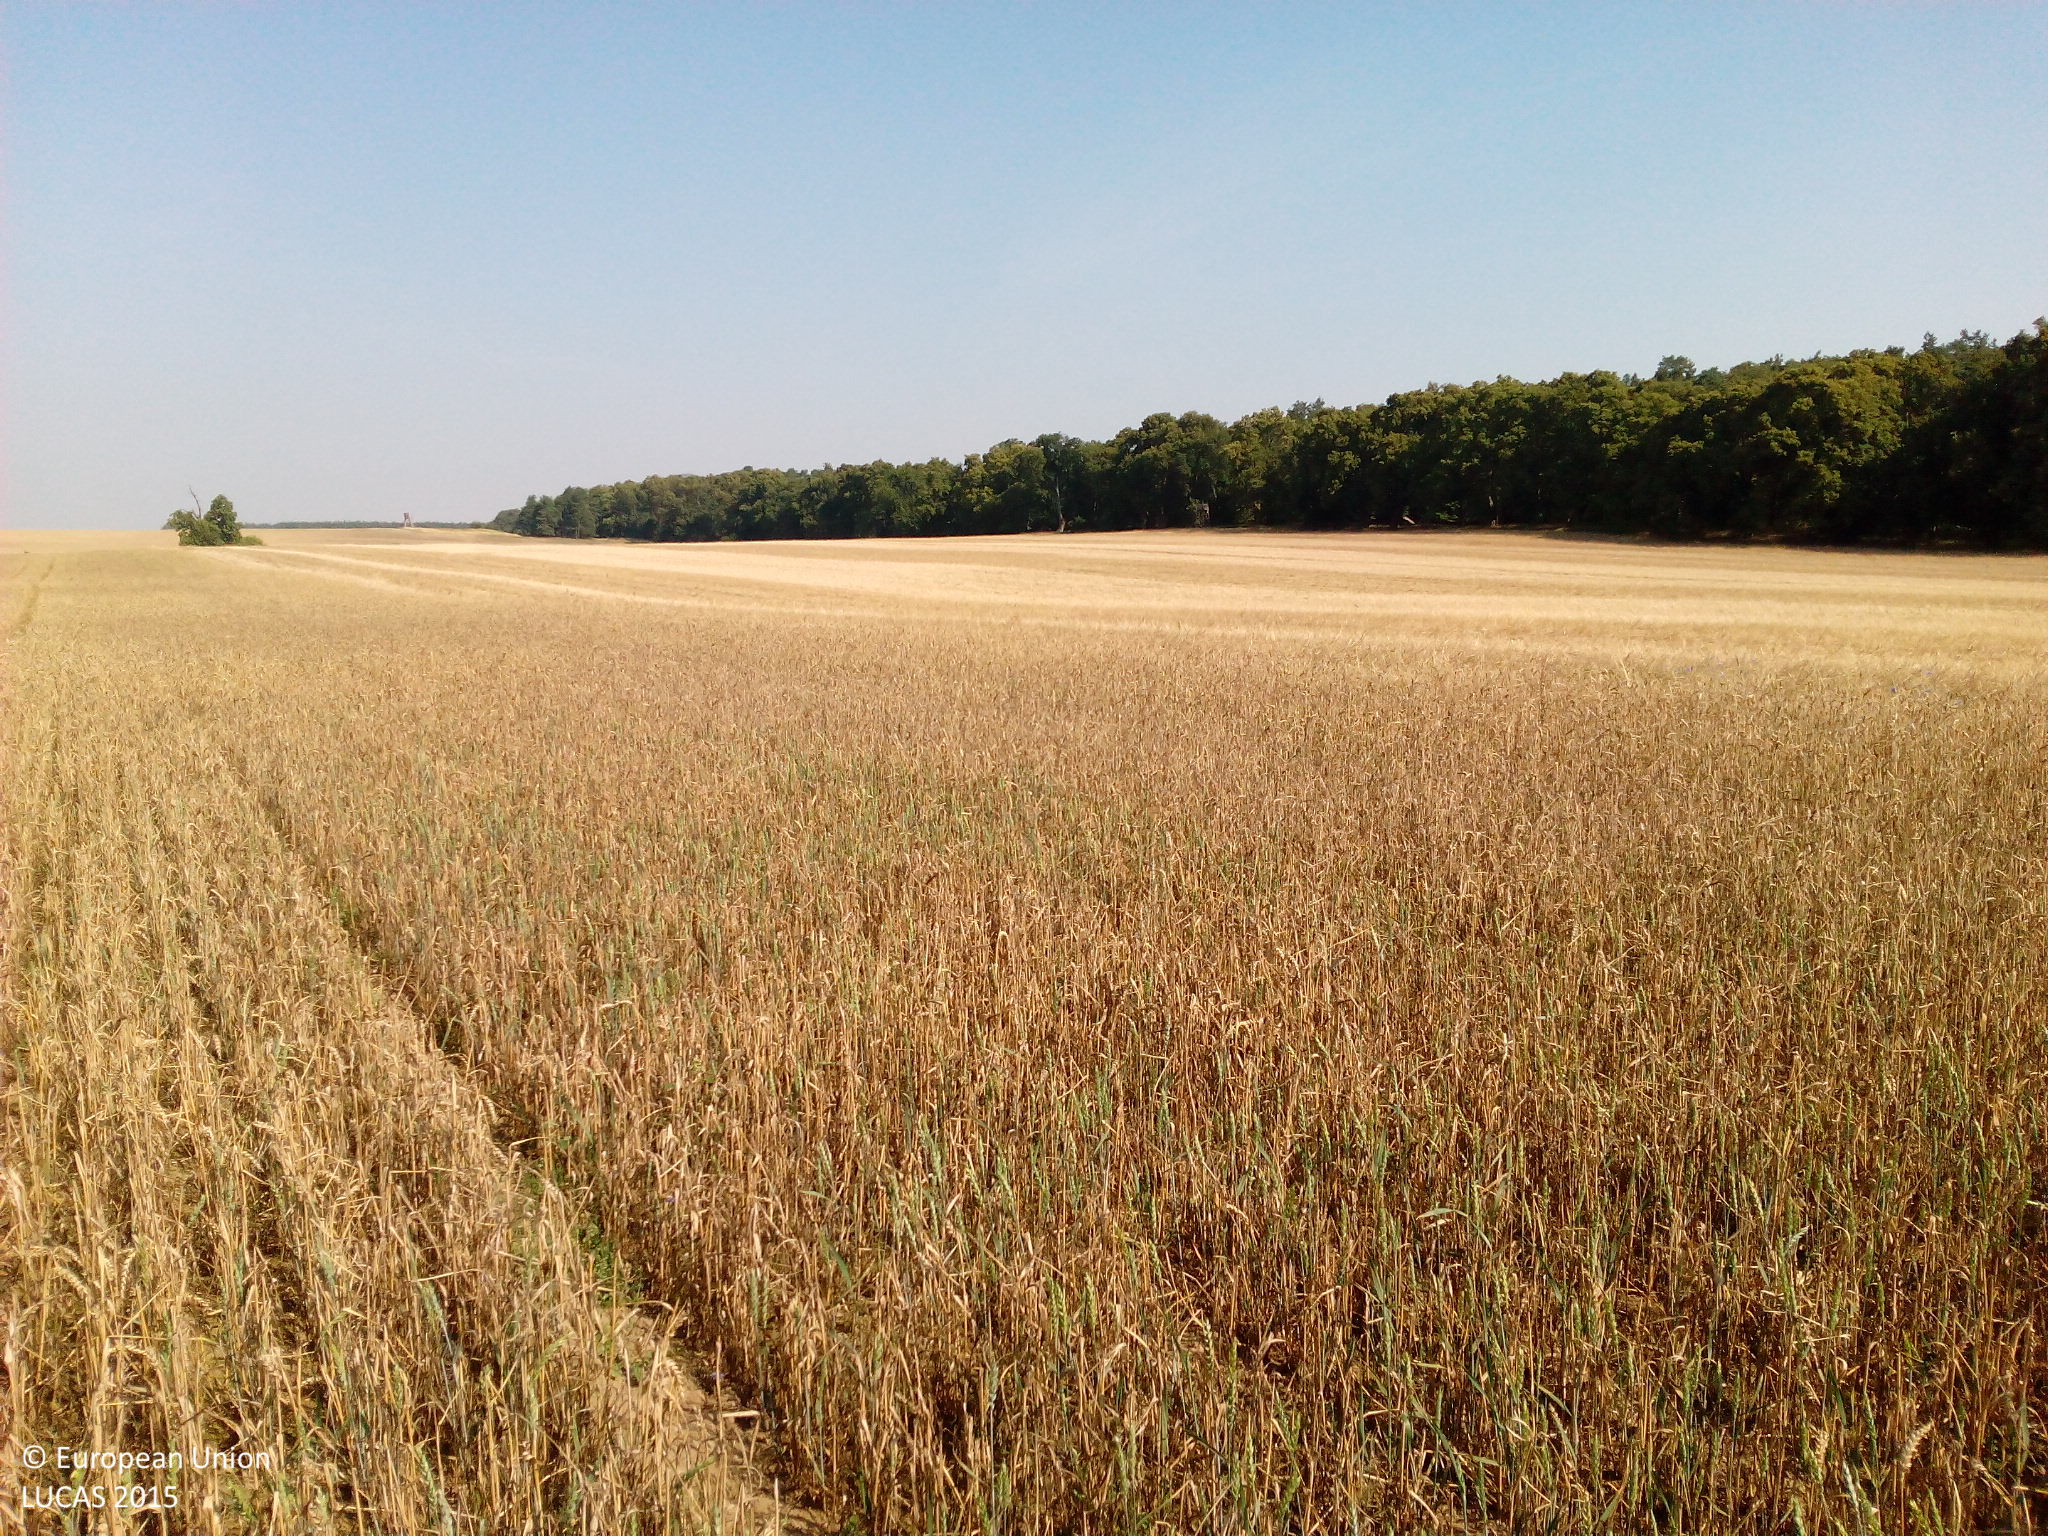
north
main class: Cropland
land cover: Common wheat
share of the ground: 25 - 50 %
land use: Agriculture (excluding fallow land and kitchen gardens)
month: August
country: DE
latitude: 53.2949
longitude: 13.5857
